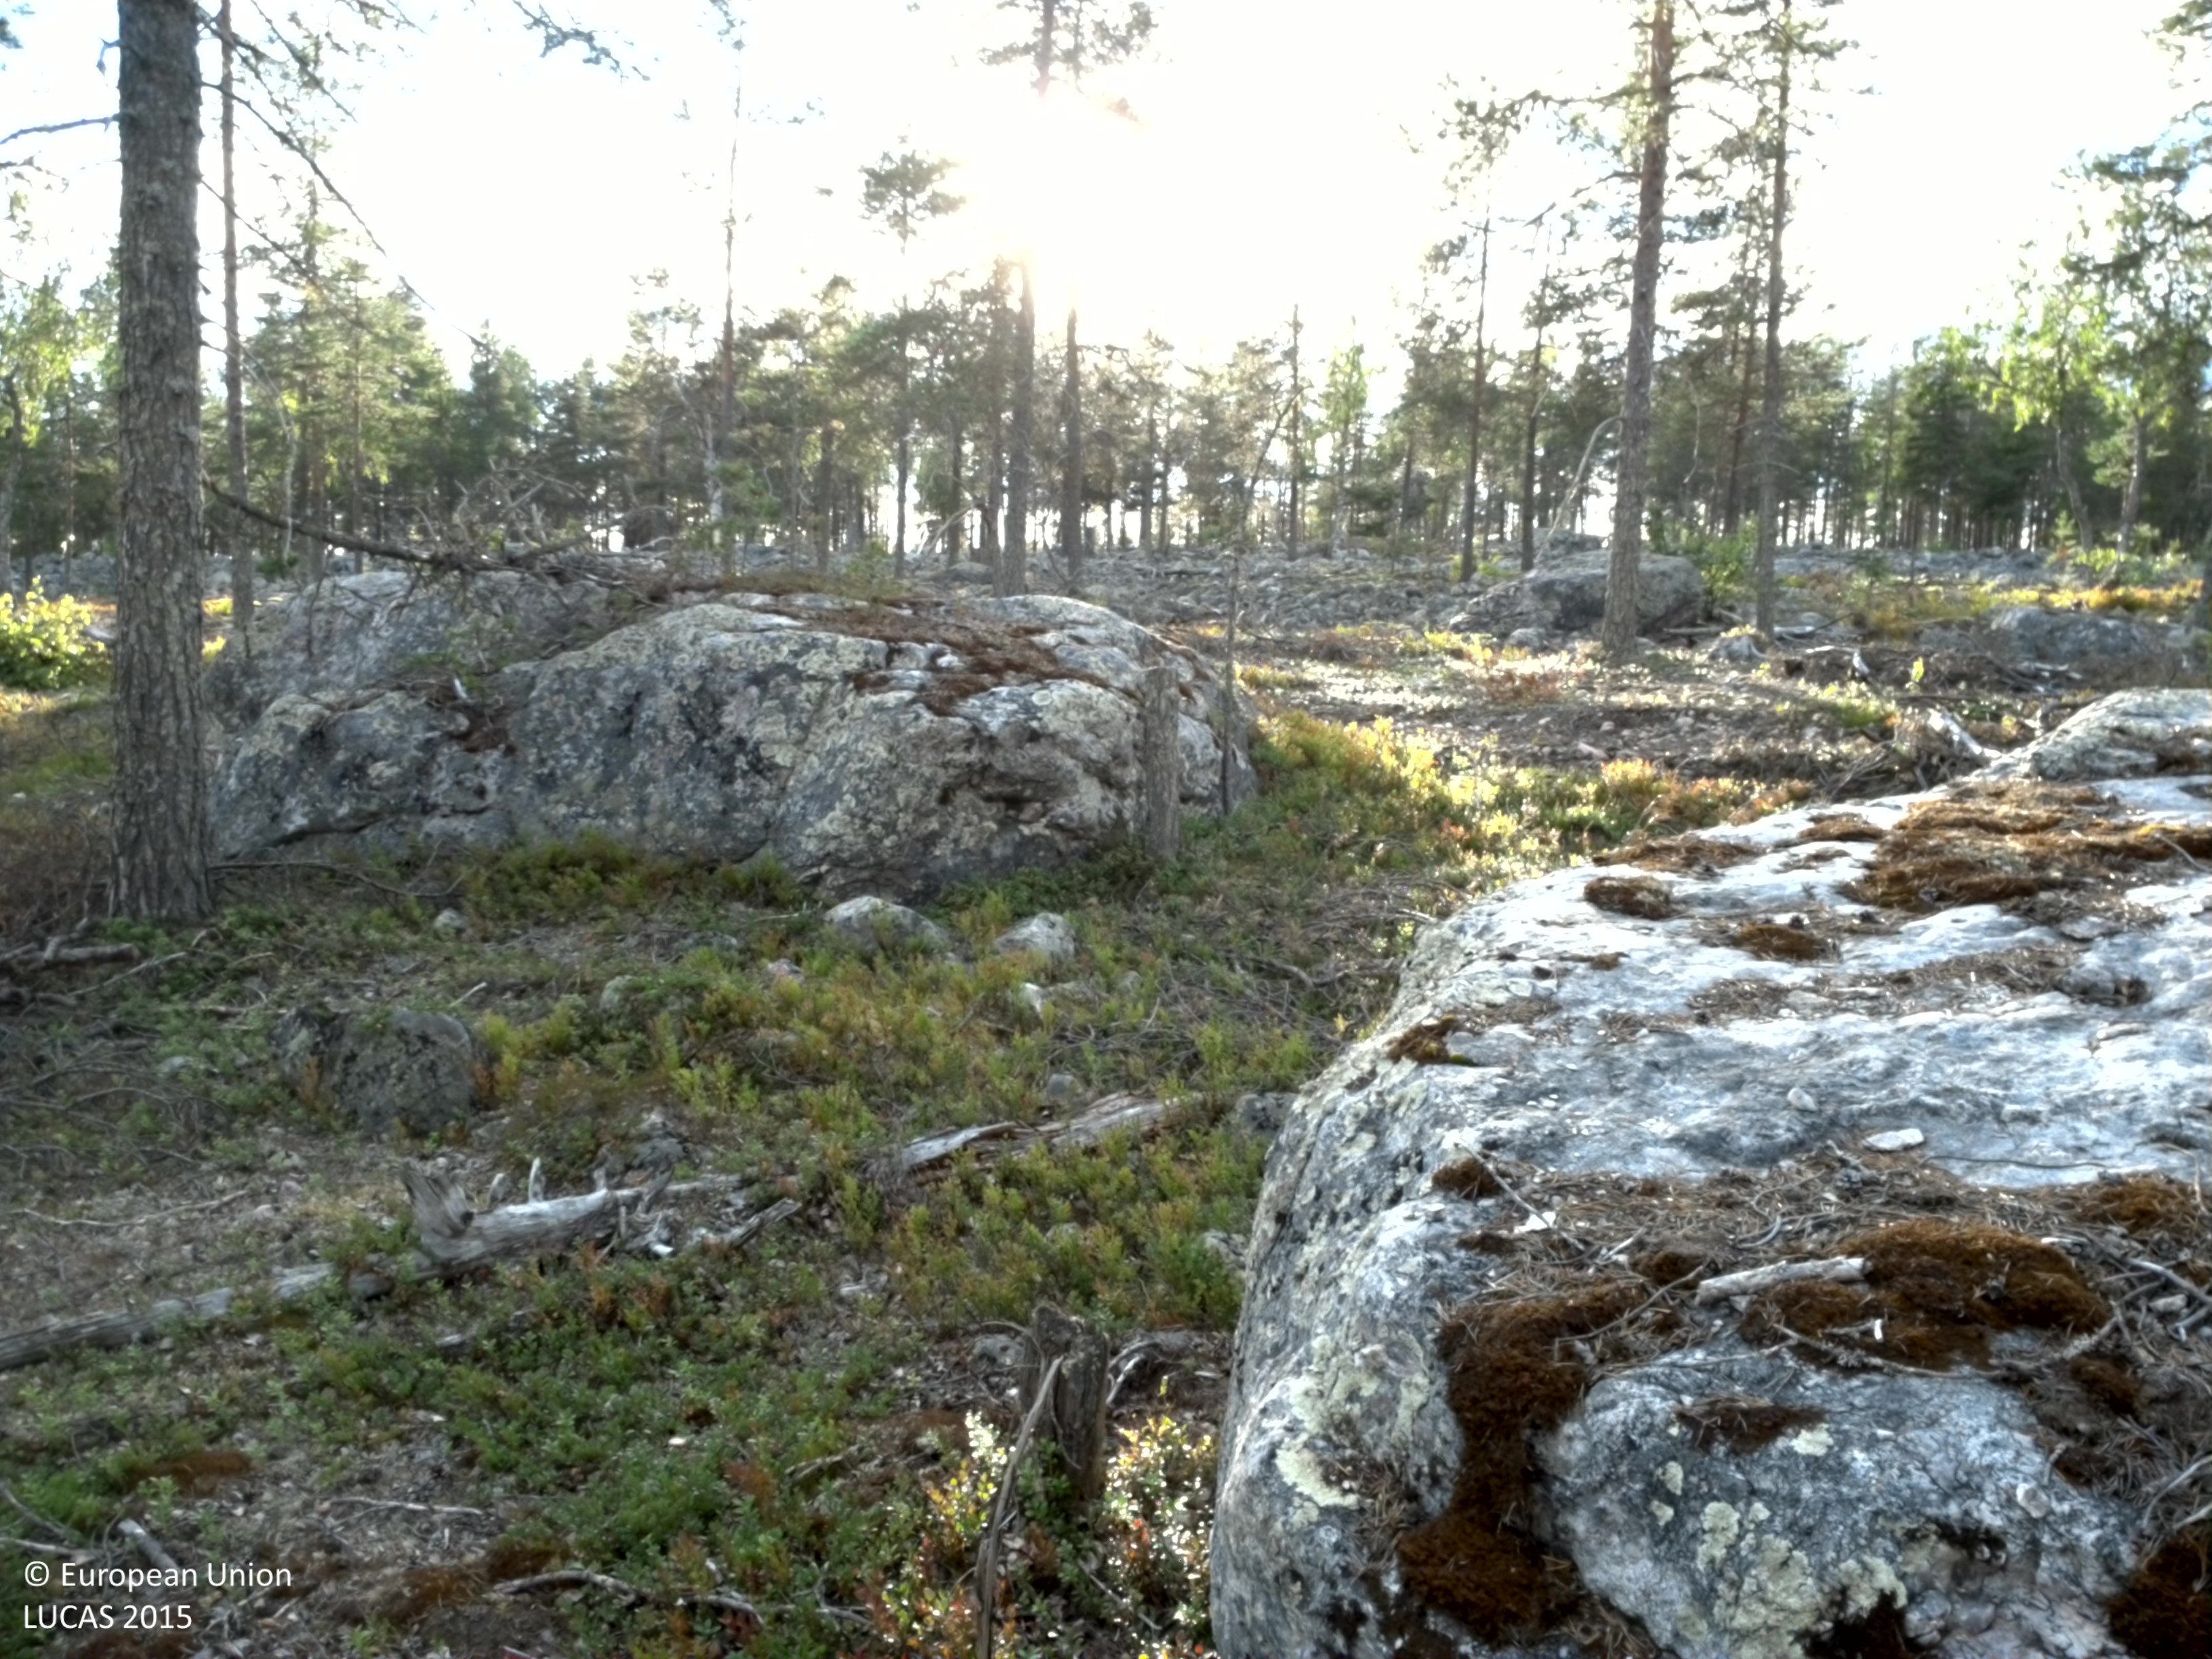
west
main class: Woodland
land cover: Pine dominated coniferous woodland
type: boreal forest
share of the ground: 10 - 25 %
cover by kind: shrubs 40 %, consolidated bare surface 25 %, lichens and mosses 20 %, coniferous forest trees 15 %
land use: Forestry
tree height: > 5 m
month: August
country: SE
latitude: 66.1569
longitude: 22.7711
